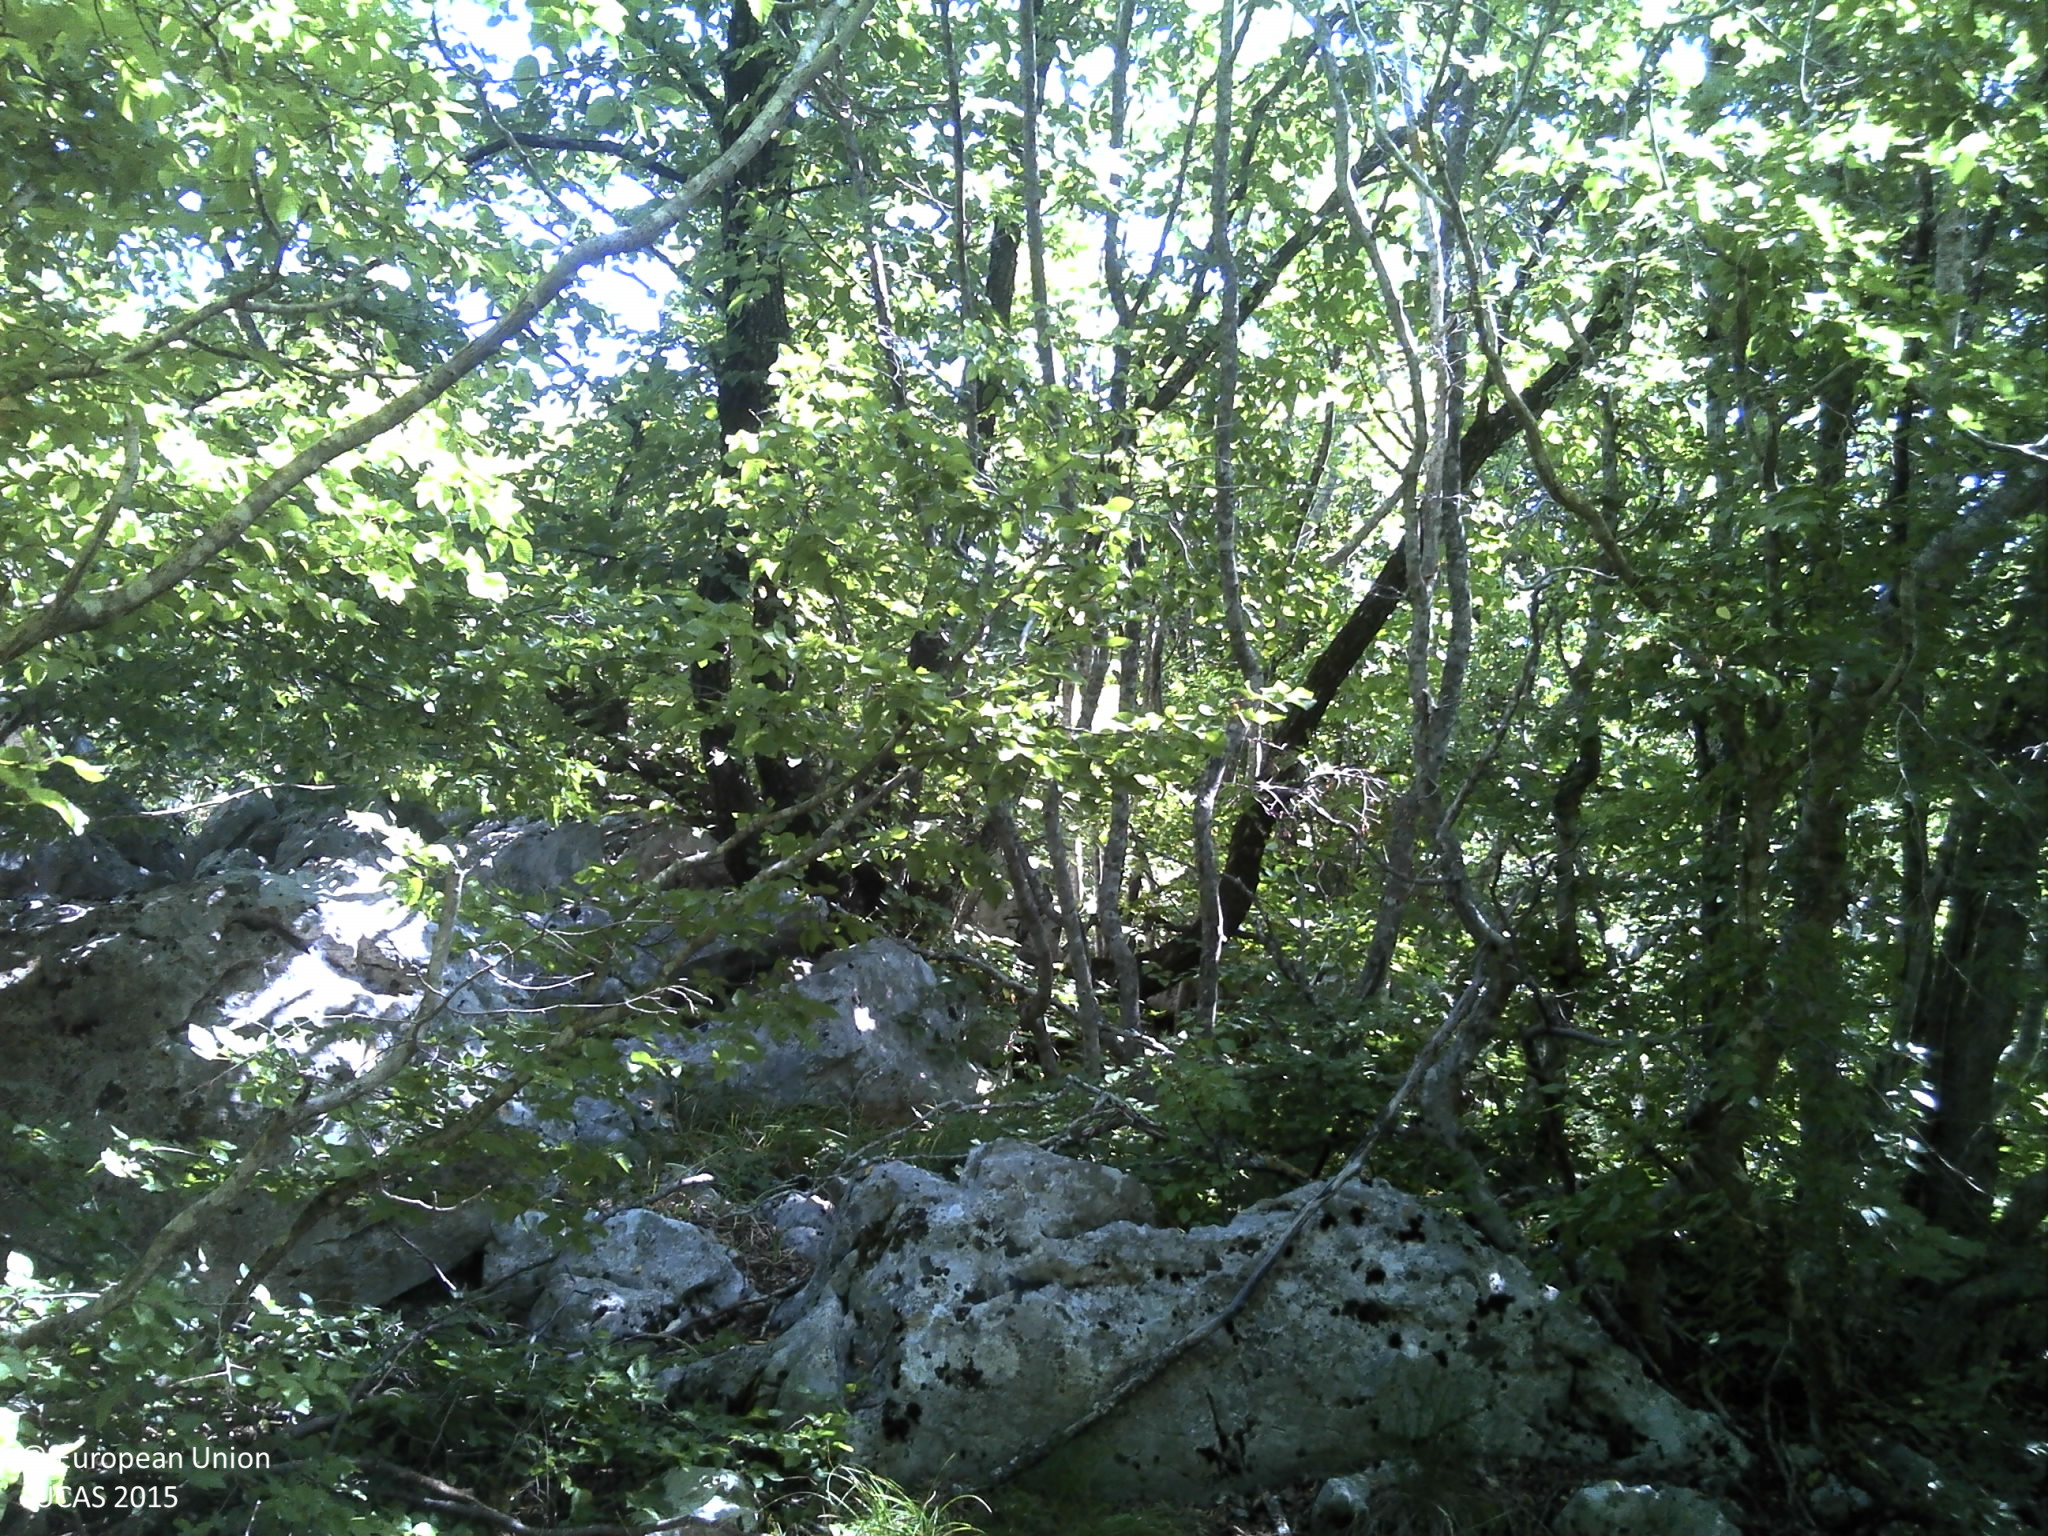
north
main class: Woodland
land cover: Broadleaved woodland
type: thermophilous deciduous forest
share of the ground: 25 - 50 %
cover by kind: broadleaved forest trees 50 %, shrubs 25 %, consolidated bare surface 15 %, herbaceous plants 5 %, lichens and mosses 5 %
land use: Semi-natural and natural areas not in use
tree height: > 5 m
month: July
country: HR
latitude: 43.5701
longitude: 17.0125
